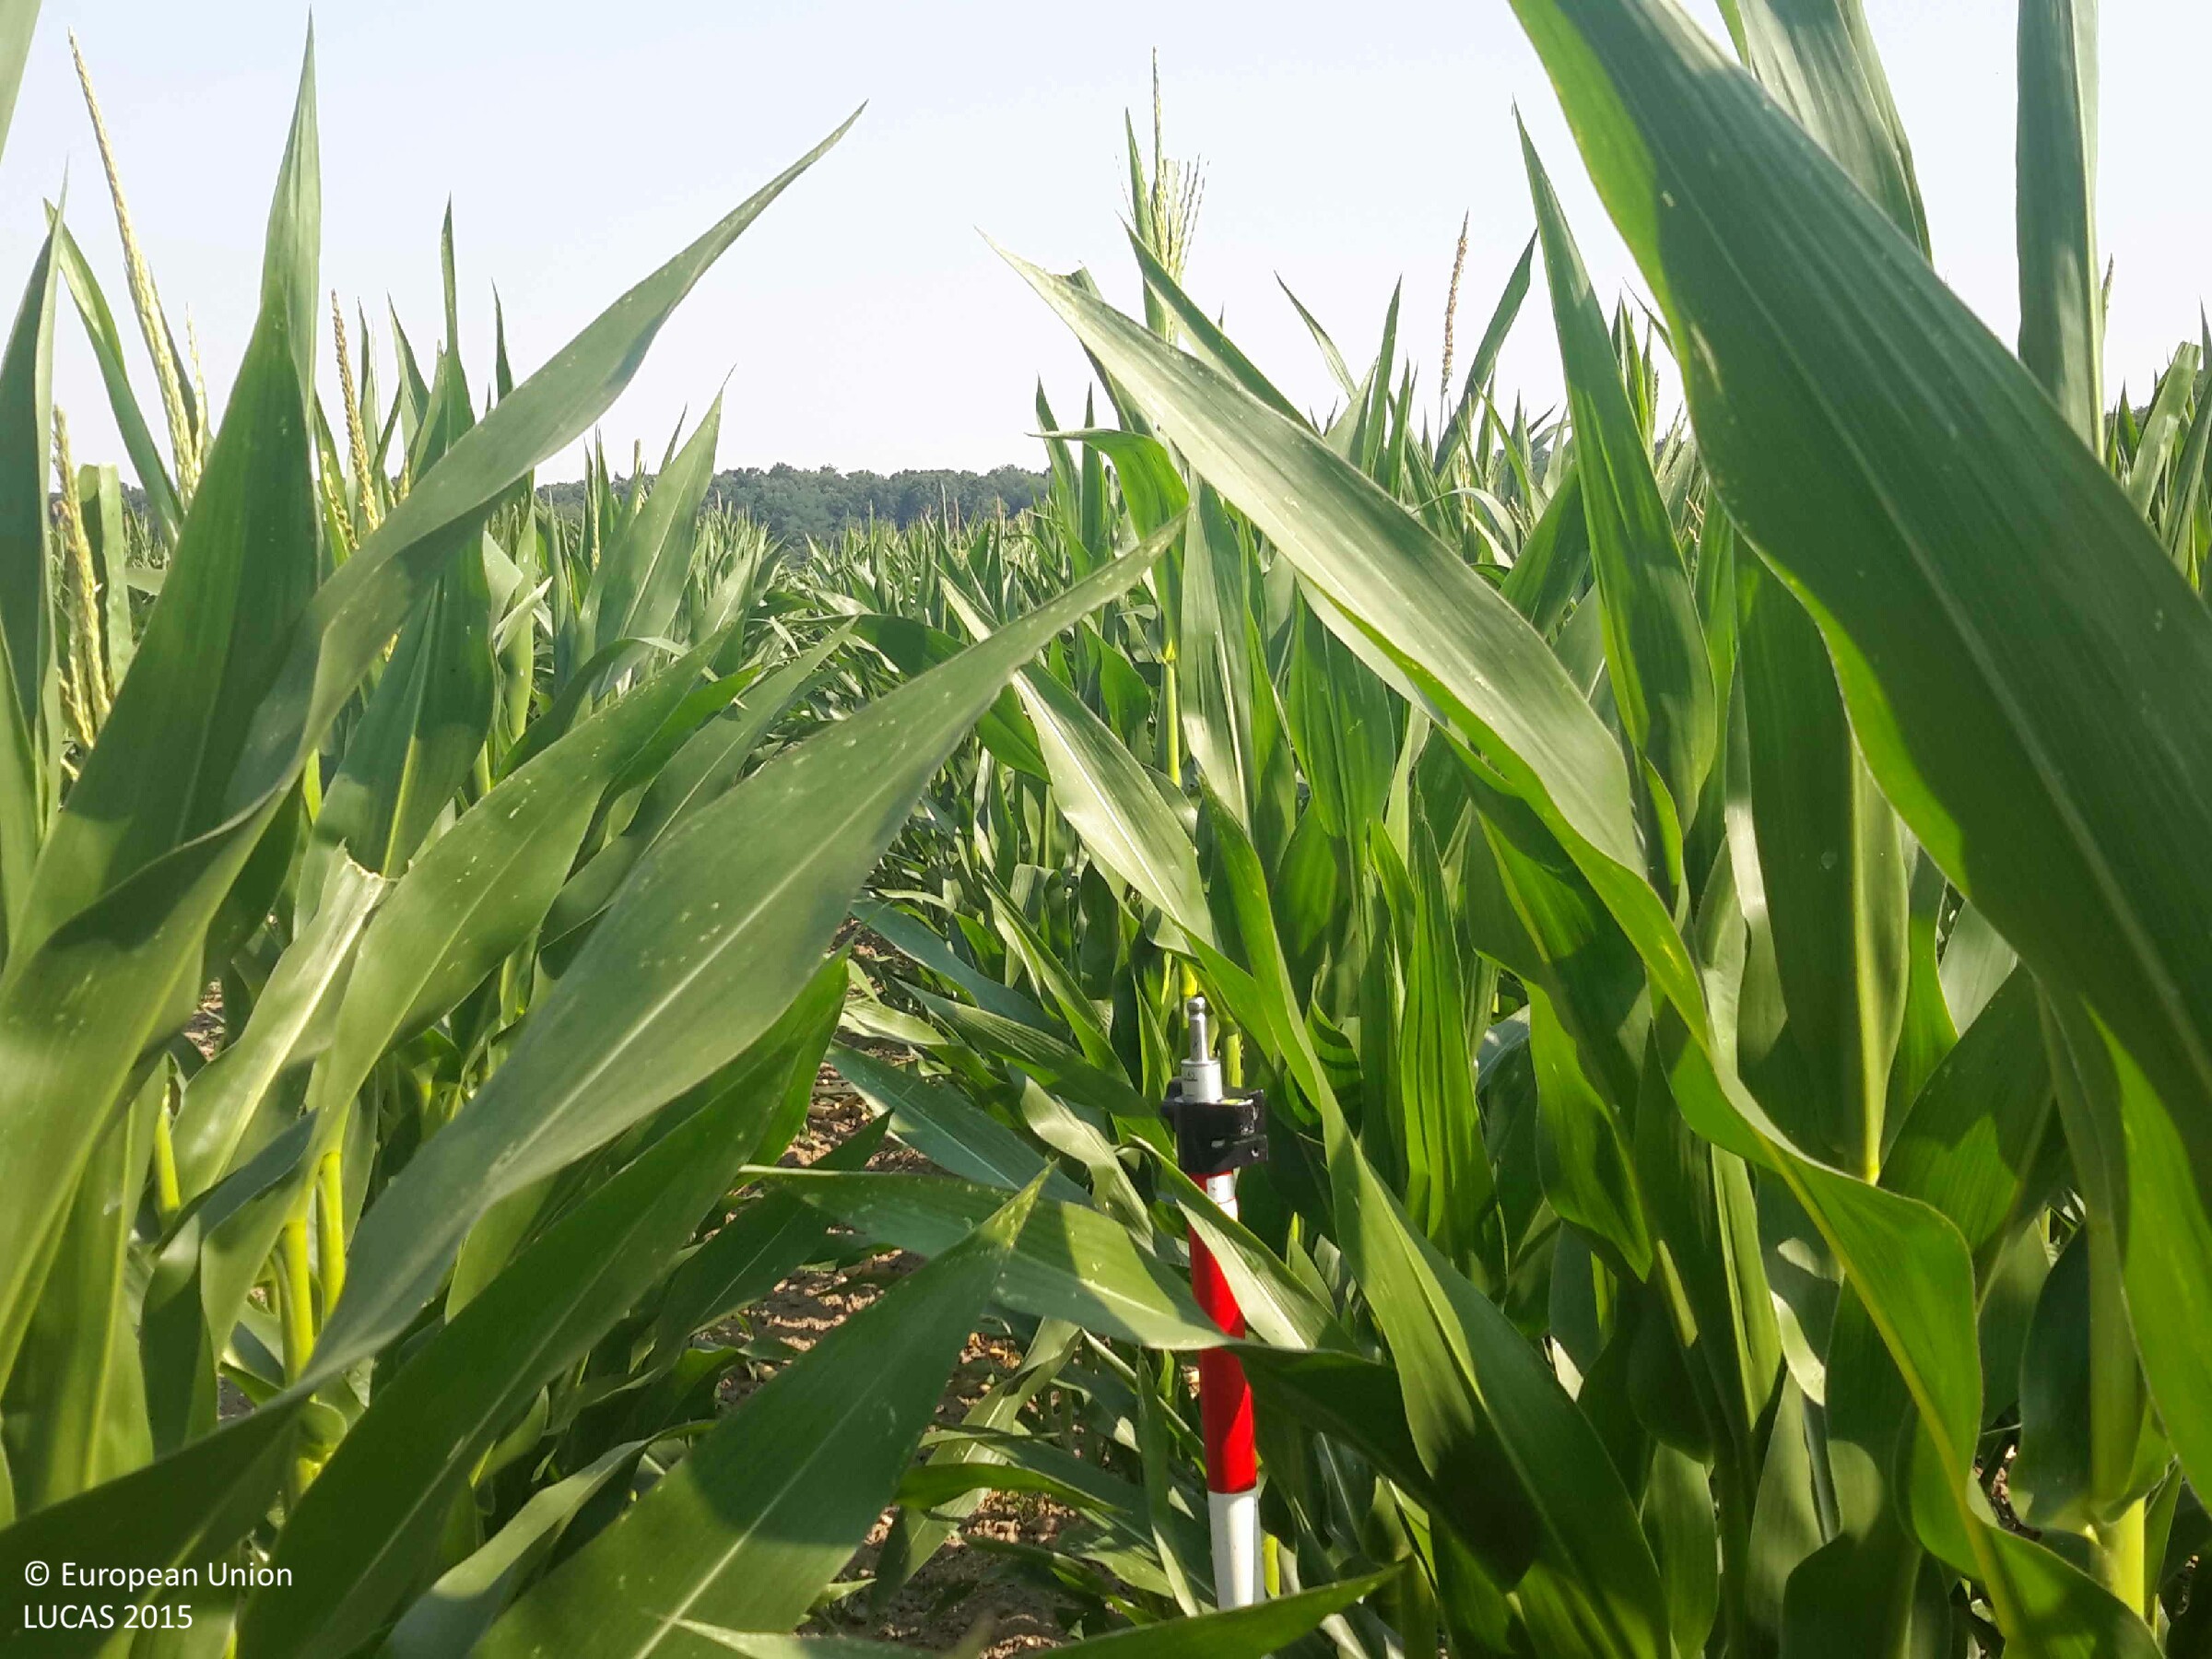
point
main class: Cropland
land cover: Maize
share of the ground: > 75 %
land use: Agriculture (excluding fallow land and kitchen gardens)
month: July
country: HU
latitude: 47.2127
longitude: 17.1752
